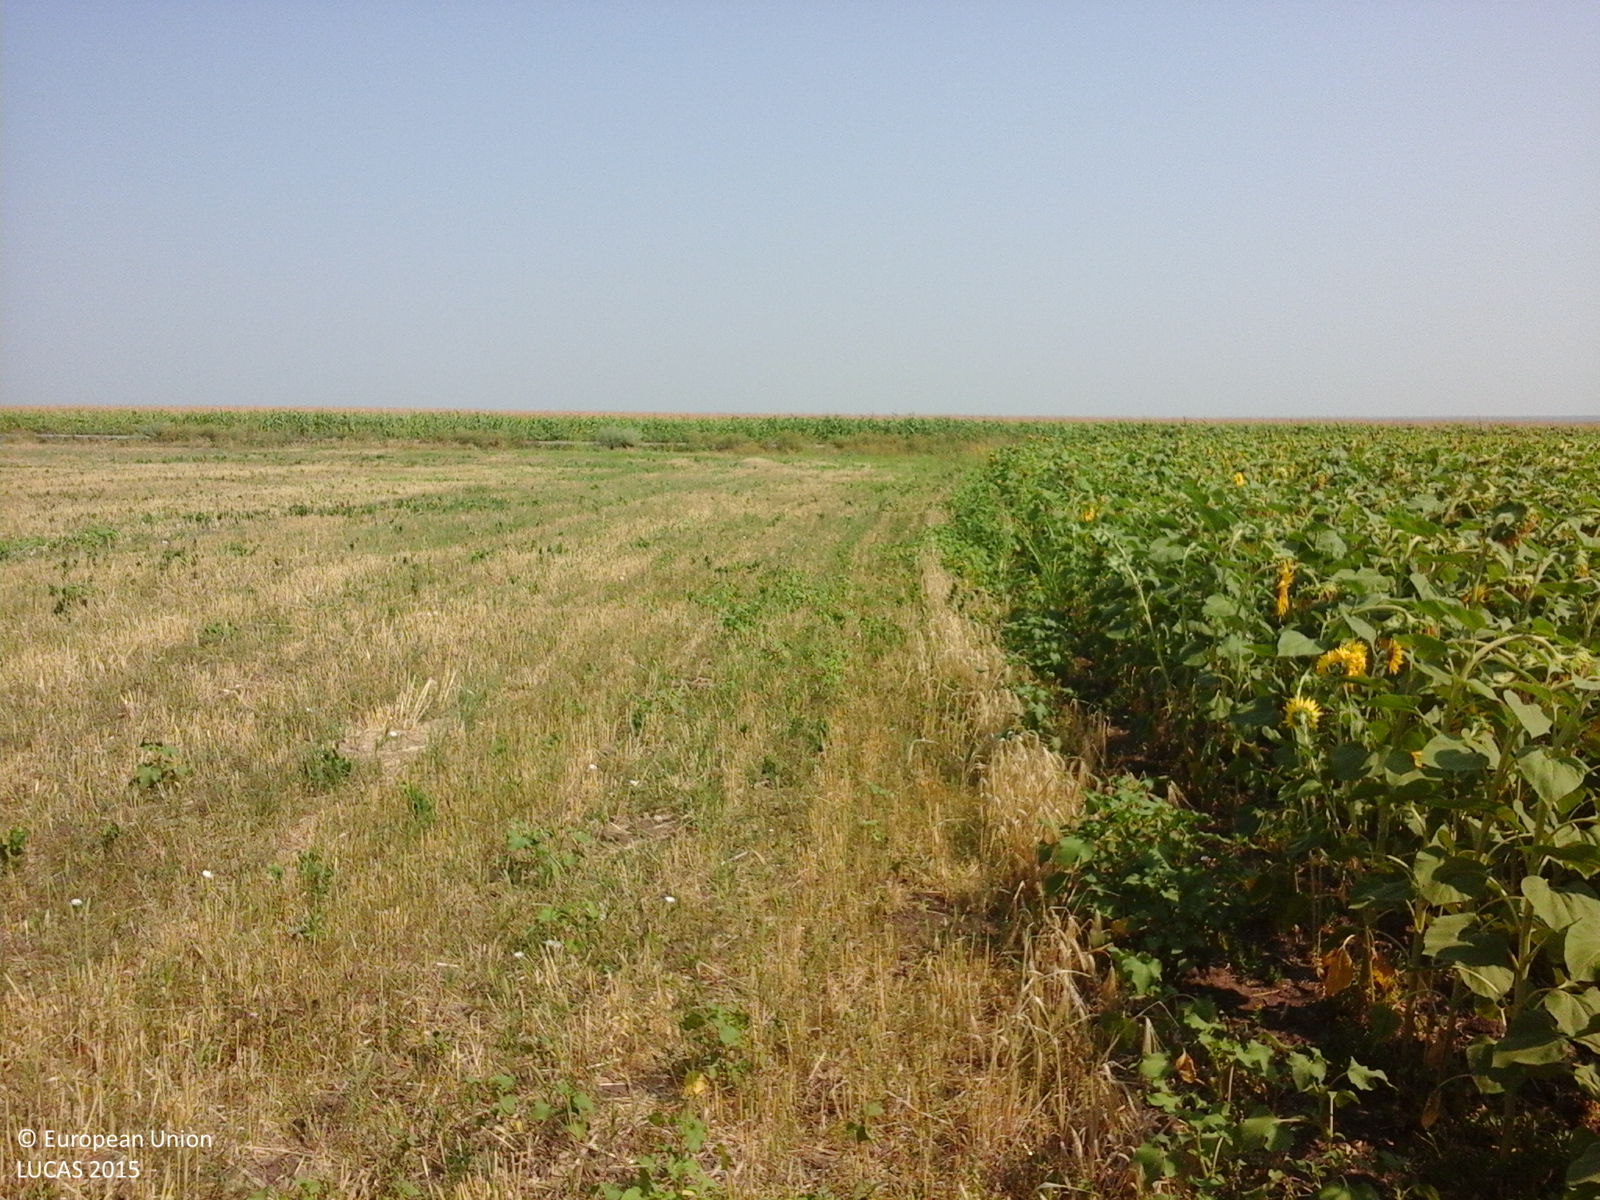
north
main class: Cropland
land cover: Sunflower
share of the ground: > 75 %
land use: Agriculture (excluding fallow land and kitchen gardens)
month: July
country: RO
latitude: 45.5605
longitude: 27.8046
